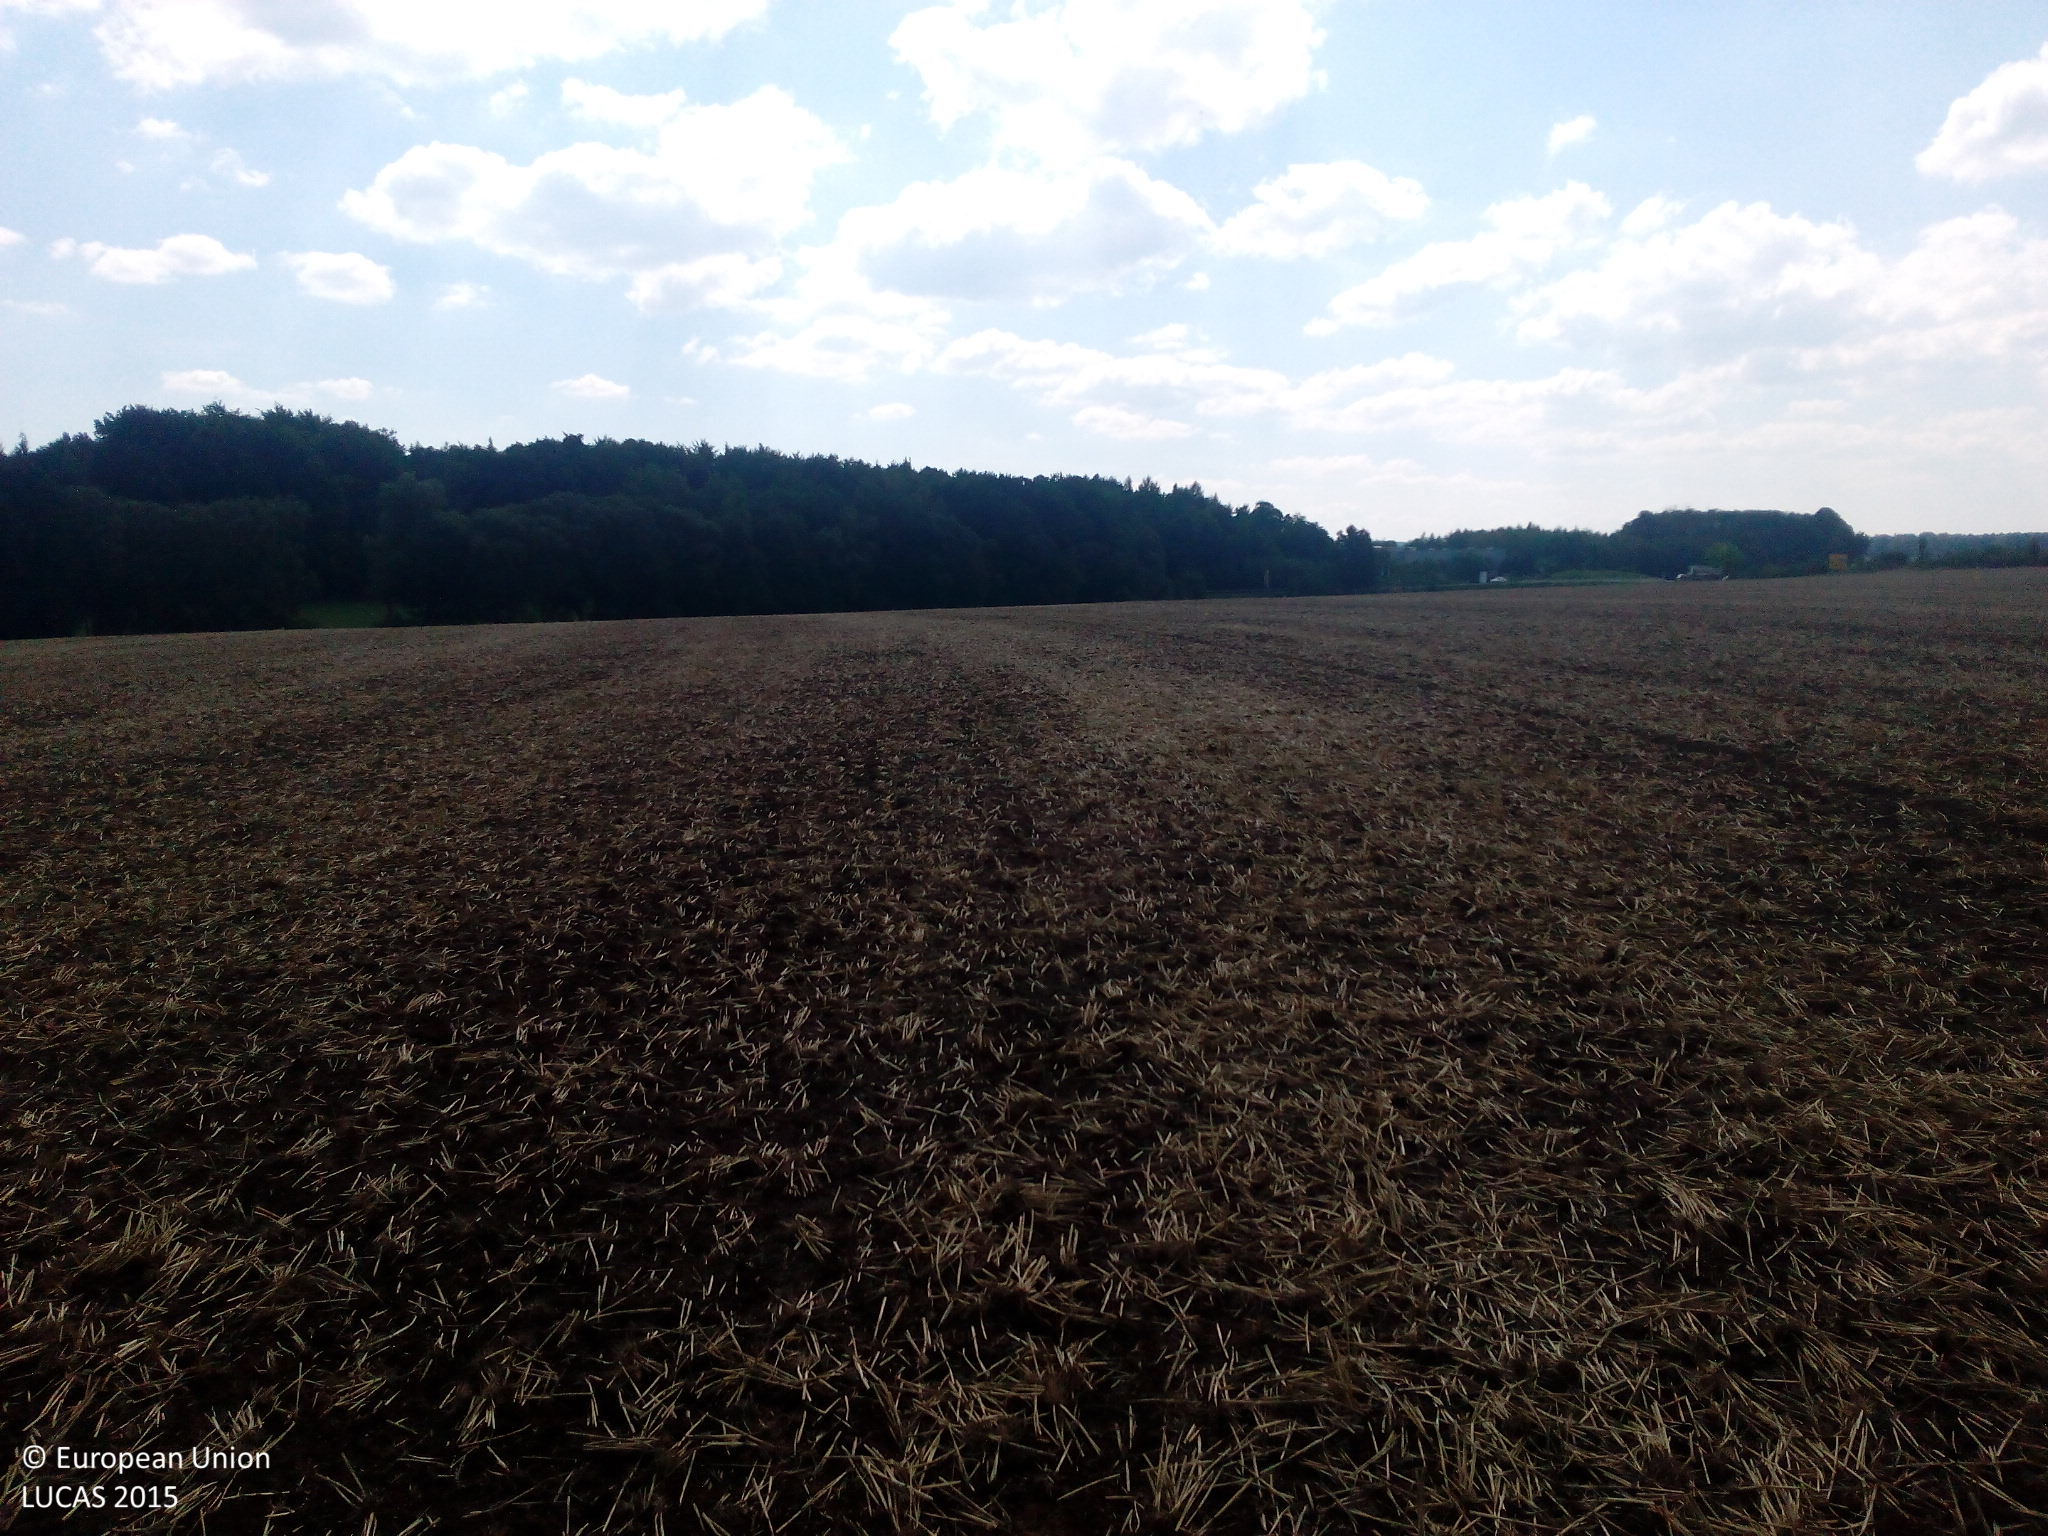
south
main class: Cropland
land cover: Common wheat
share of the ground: 10 - 25 %
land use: Agriculture (excluding fallow land and kitchen gardens)
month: August
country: DE
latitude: 50.9233
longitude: 14.0271
